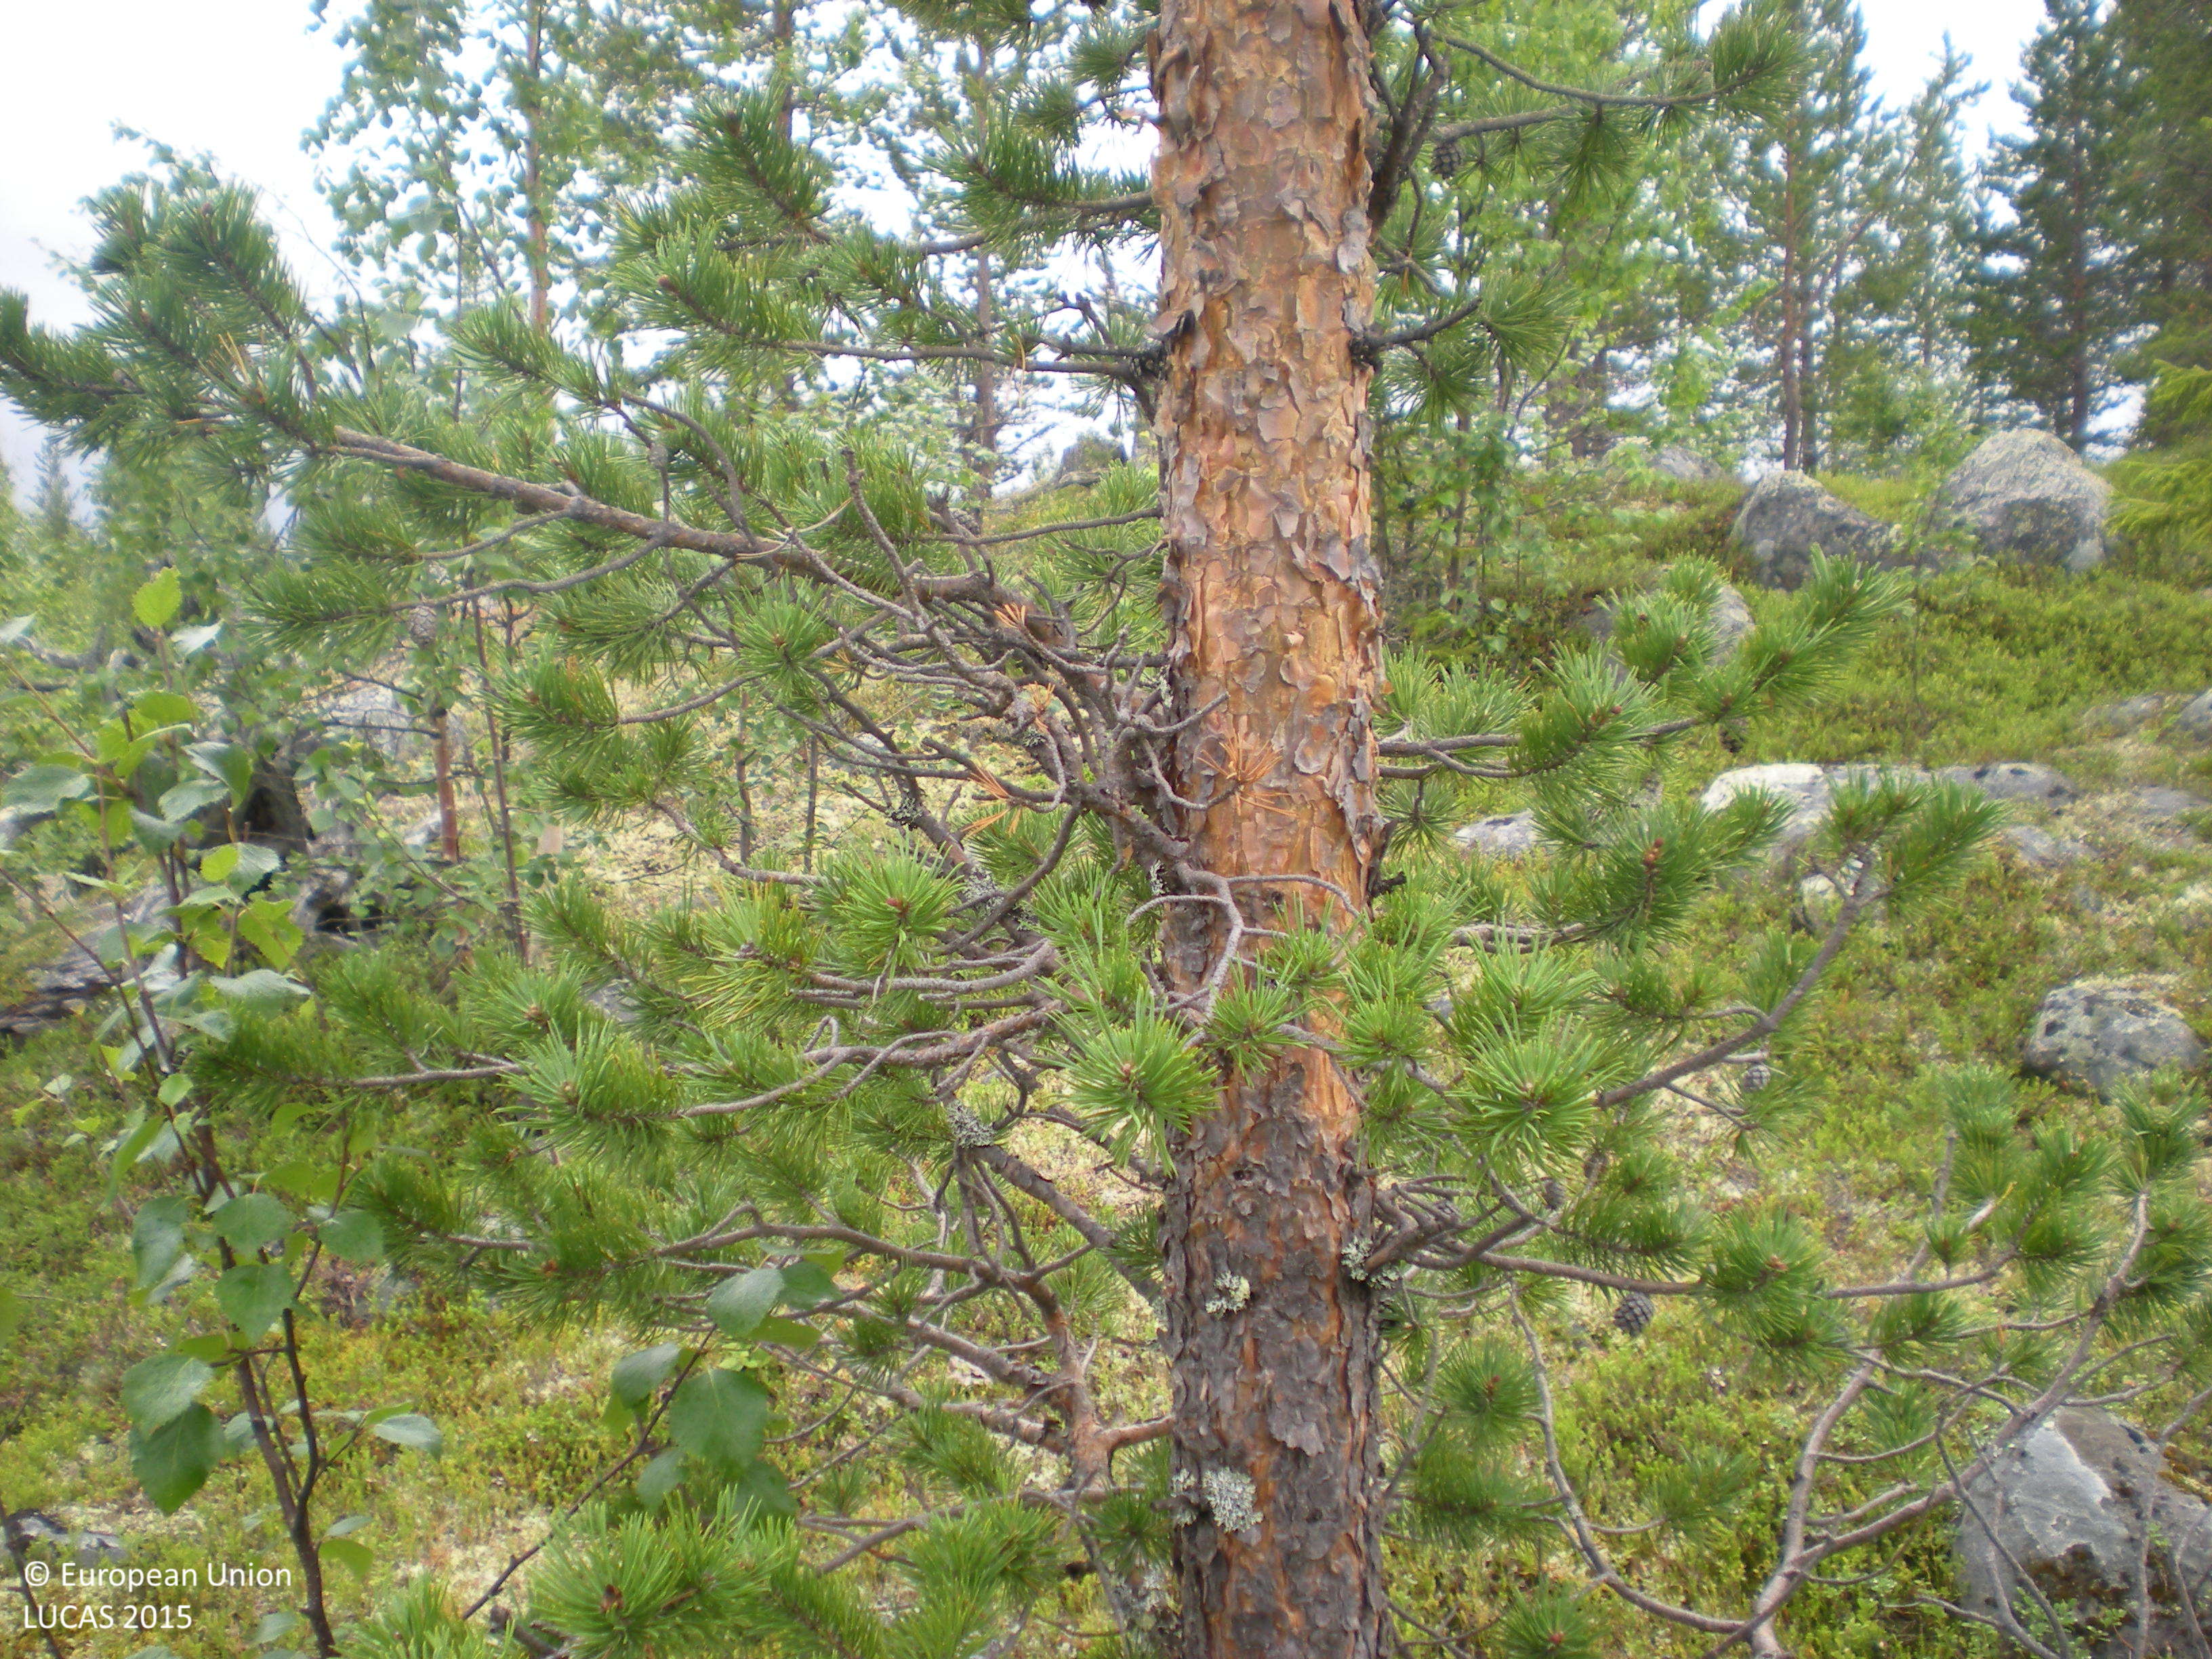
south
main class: Woodland
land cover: Pine dominated mixed woodland
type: boreal forest
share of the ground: 50 - 75 %
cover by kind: coniferous forest trees 45 %, shrubs 20 %, broadleaved forest trees 15 %, lichens and mosses 10 %, consolidated bare surface 10 %
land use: Forestry
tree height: > 5 m
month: August
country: SE
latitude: 66.2134
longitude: 18.0192
